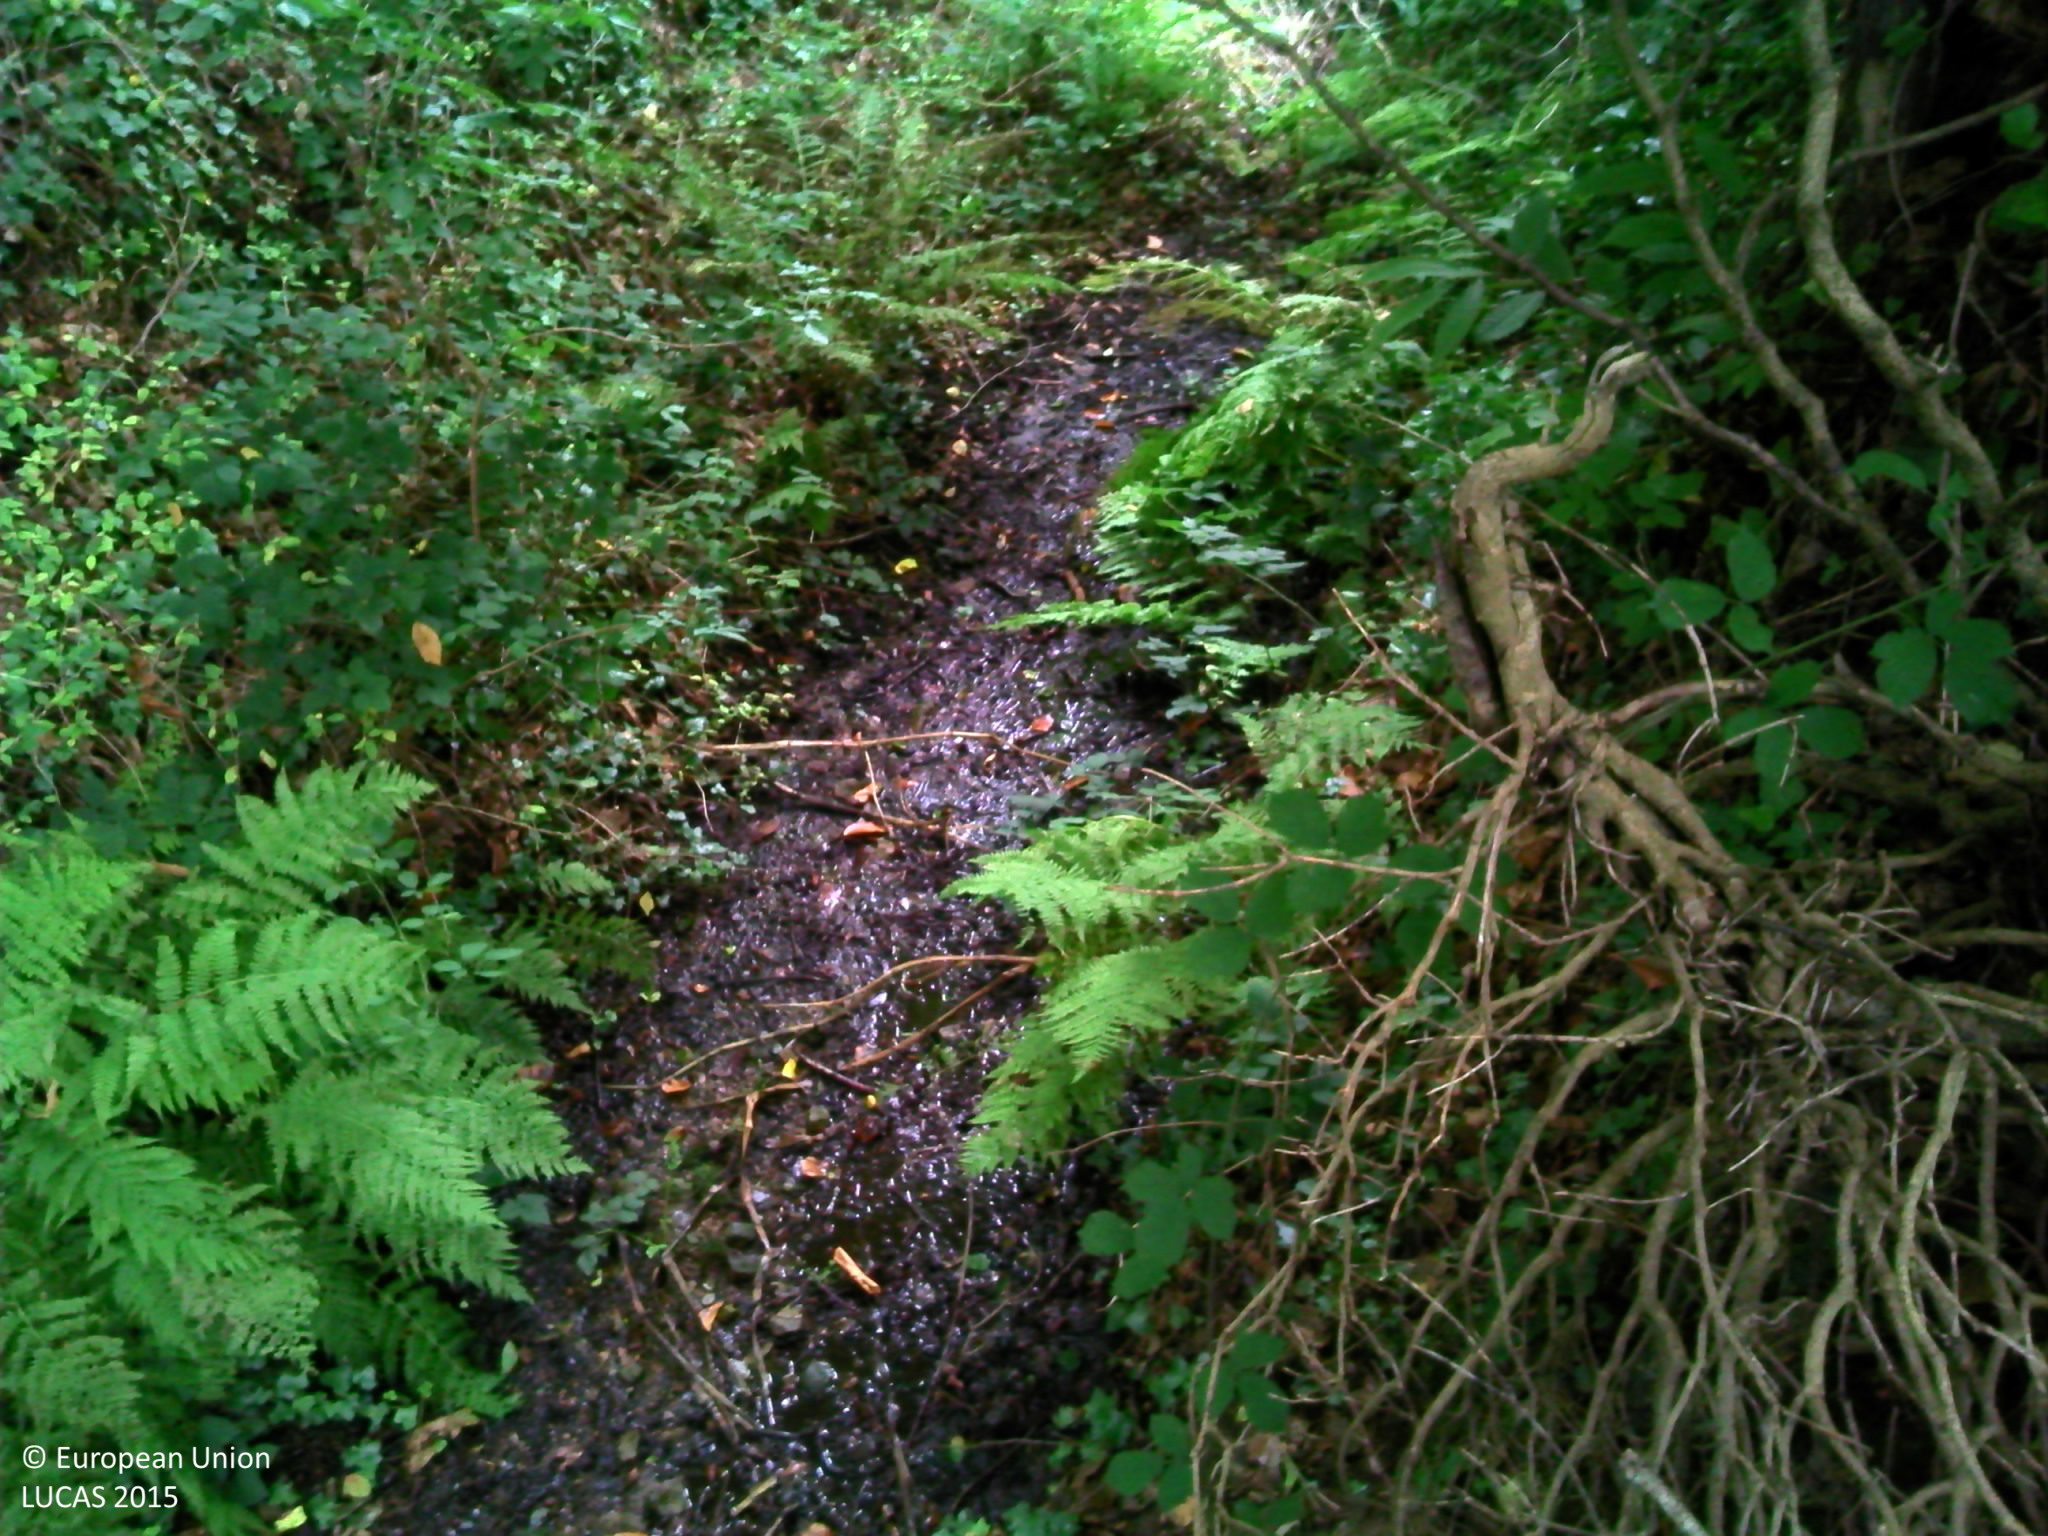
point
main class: Woodland
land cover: Broadleaved woodland
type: mesophytic deciduous forest
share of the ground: > 75 %
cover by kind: broadleaved forest trees 50 %, herbaceous plants 30 %, shrubs 20 %
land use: Forestry
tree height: > 5 m
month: August
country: FR
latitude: 48.8269
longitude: -3.2198
